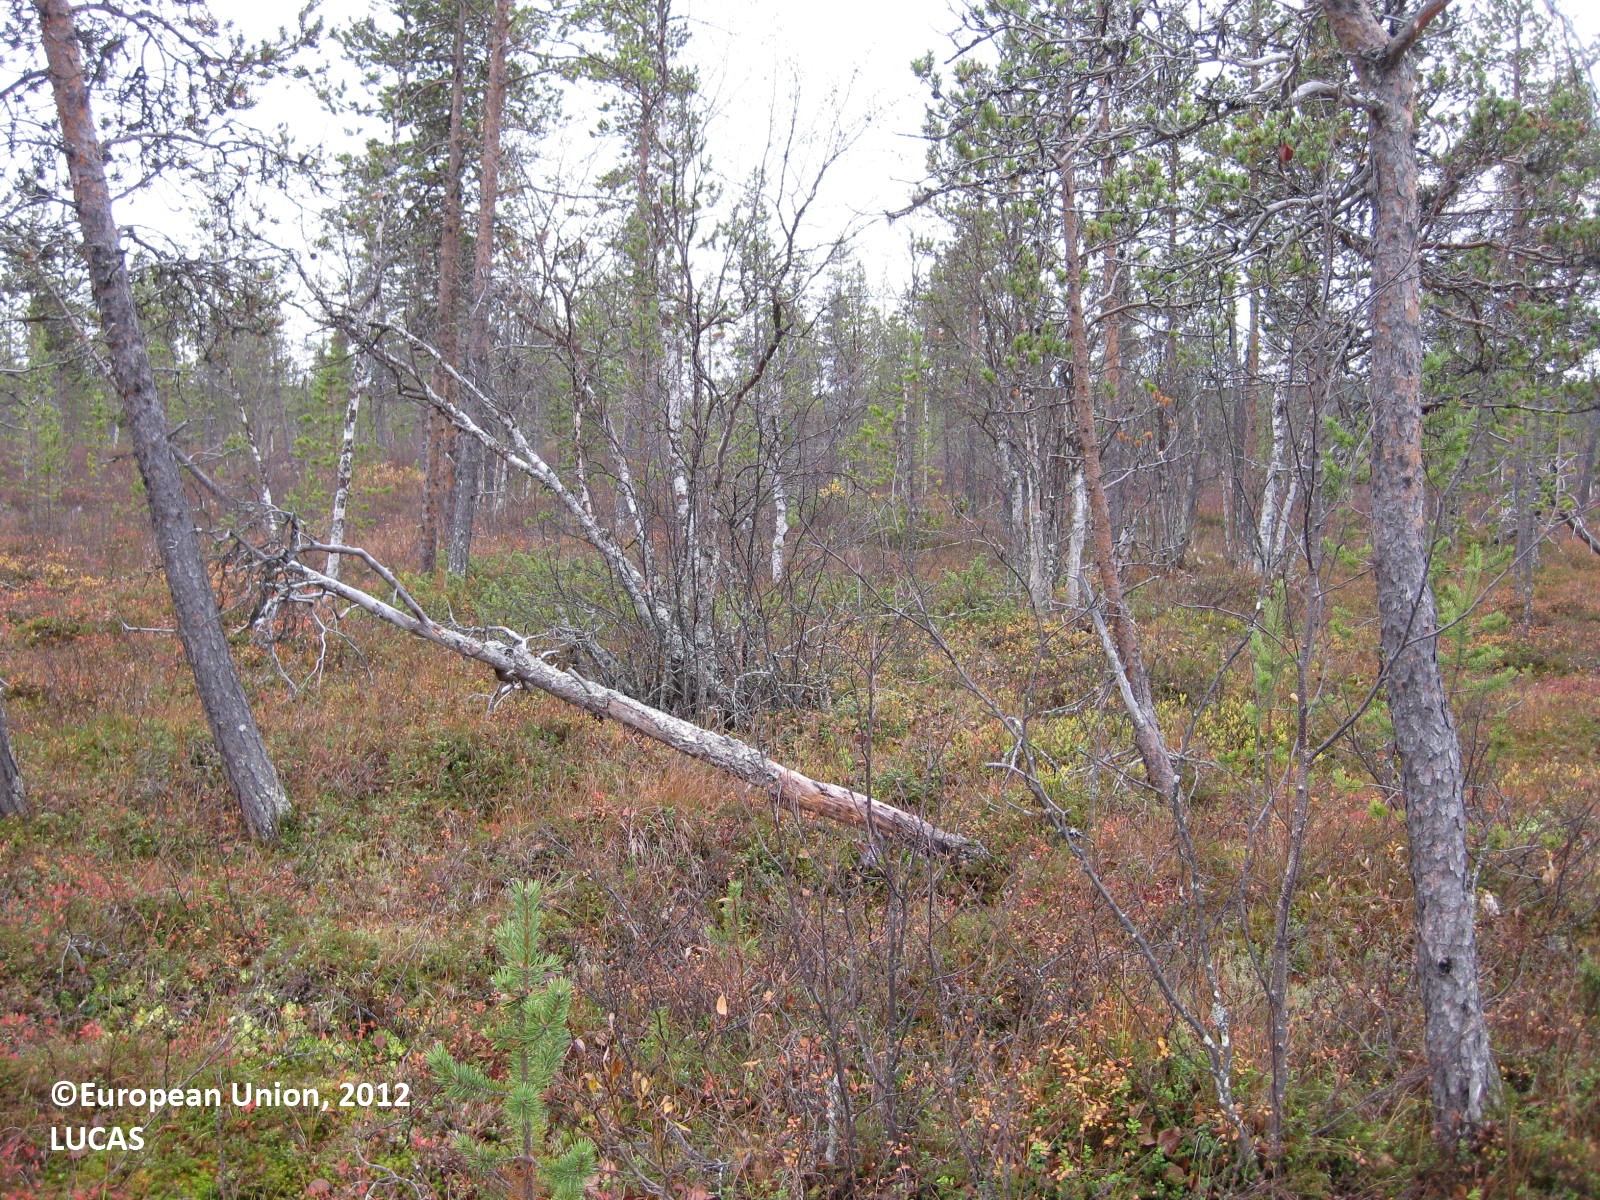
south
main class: Woodland
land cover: Other mixed woodland
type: boreal forest
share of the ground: > 75 %
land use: Forestry
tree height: > 5 m
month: September
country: FI
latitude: 68.0828
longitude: 23.6212
